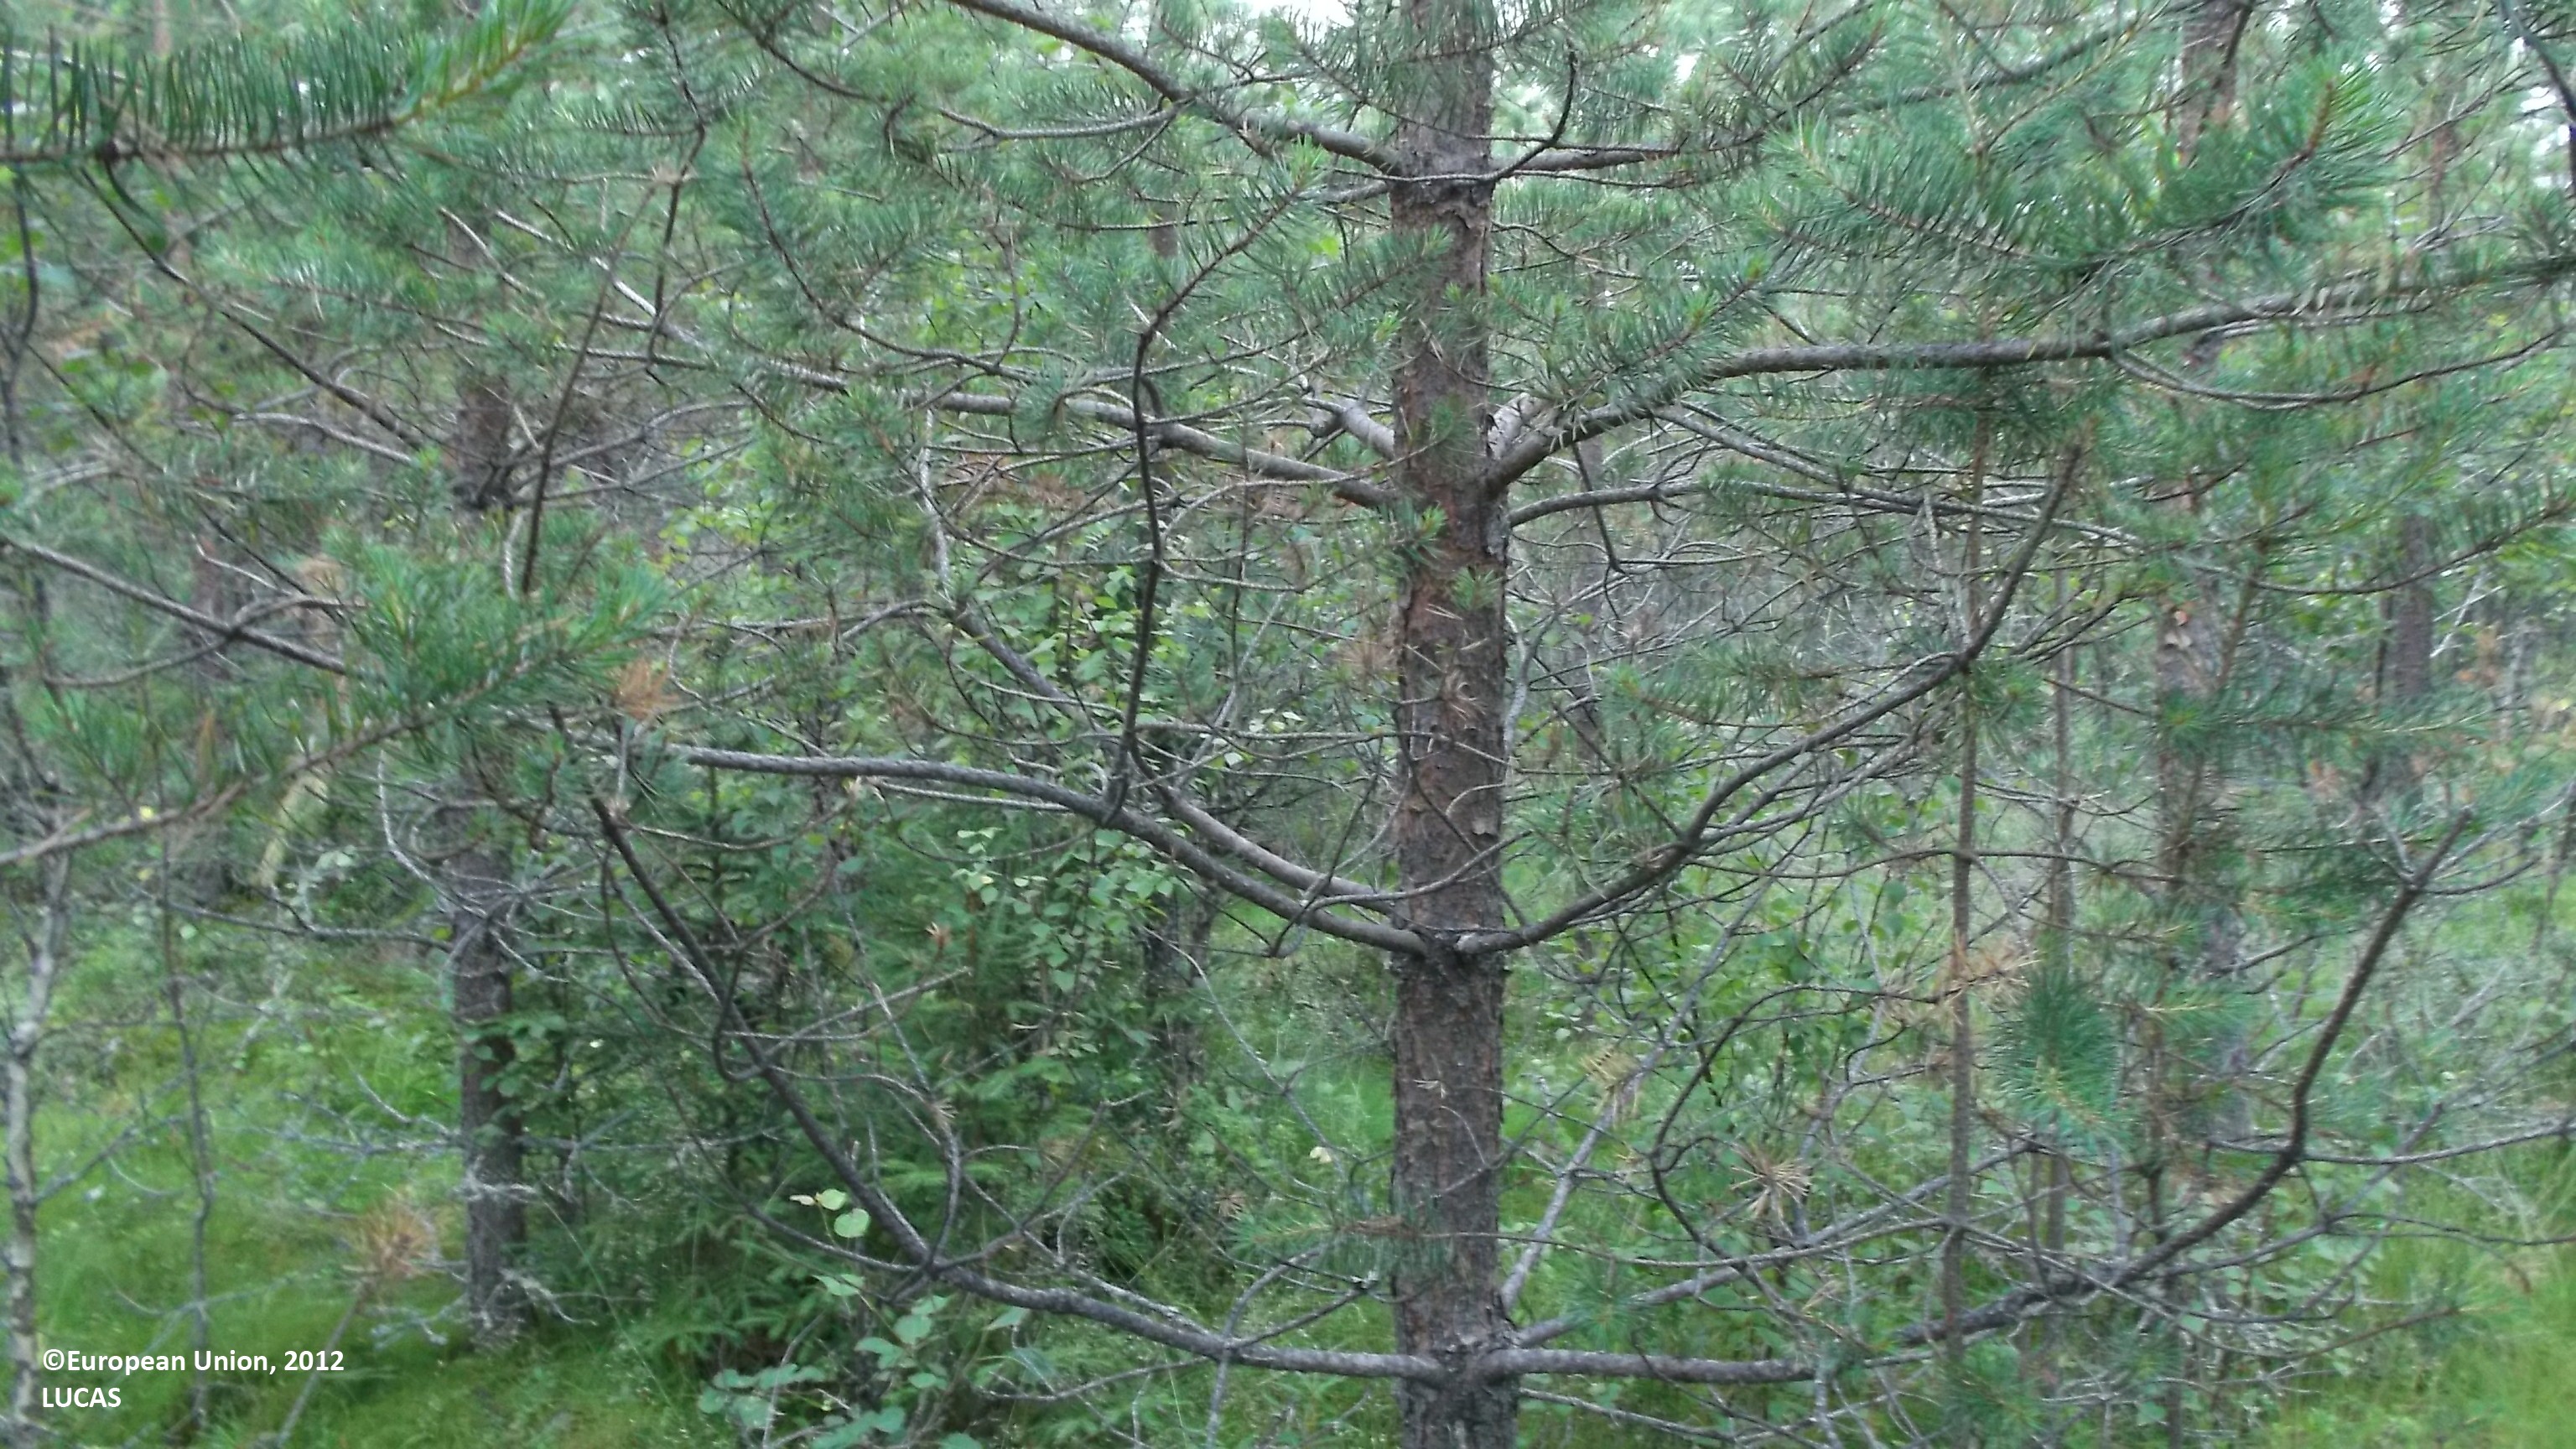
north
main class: Woodland
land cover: Pine dominated mixed woodland
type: boreal forest
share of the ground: > 75 %
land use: Forestry
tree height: > 5 m
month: July
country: FI
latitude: 63.6068
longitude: 23.1821
